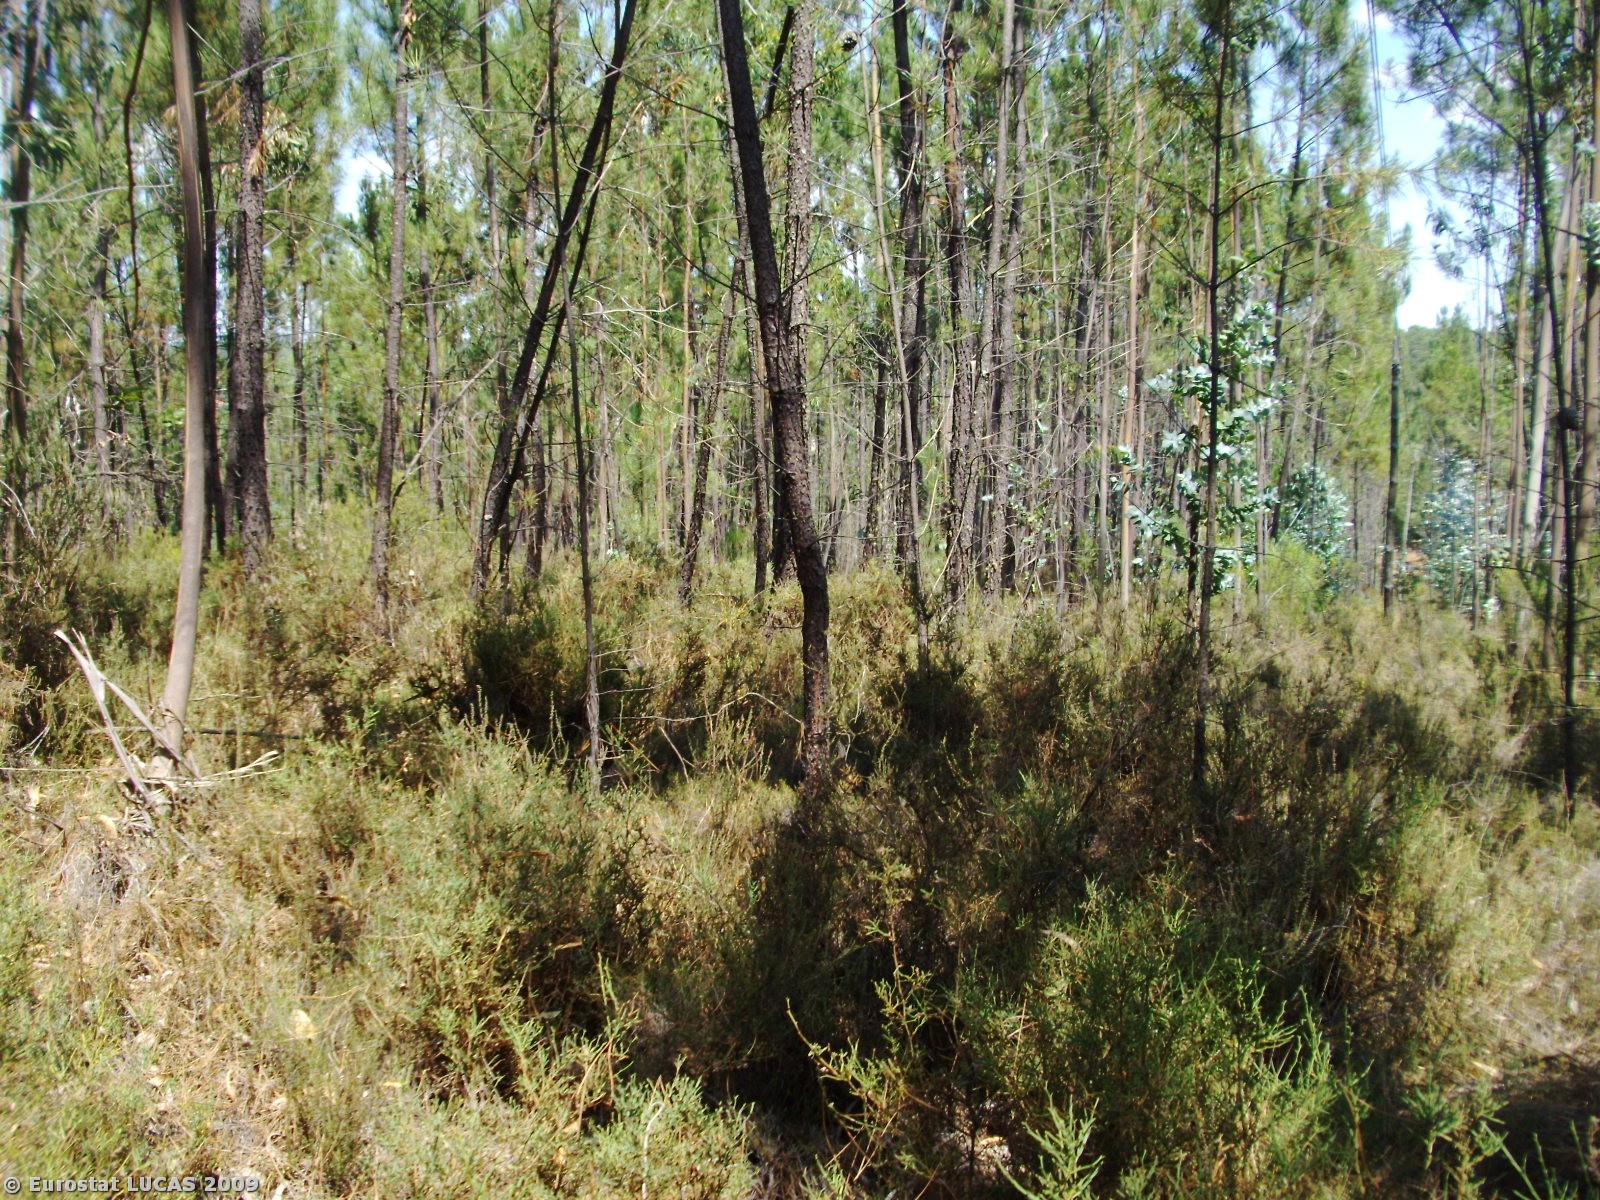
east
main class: Woodland
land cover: Coniferous woodland
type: coniferous forest of the mediterranean region
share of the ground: > 75 %
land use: Forestry
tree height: > 5 m
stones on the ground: > 50 %
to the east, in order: Coniferous woodland; Arable land (only in case pi); Single bushes/trees
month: August
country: PT
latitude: 39.9137
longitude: -8.2169
